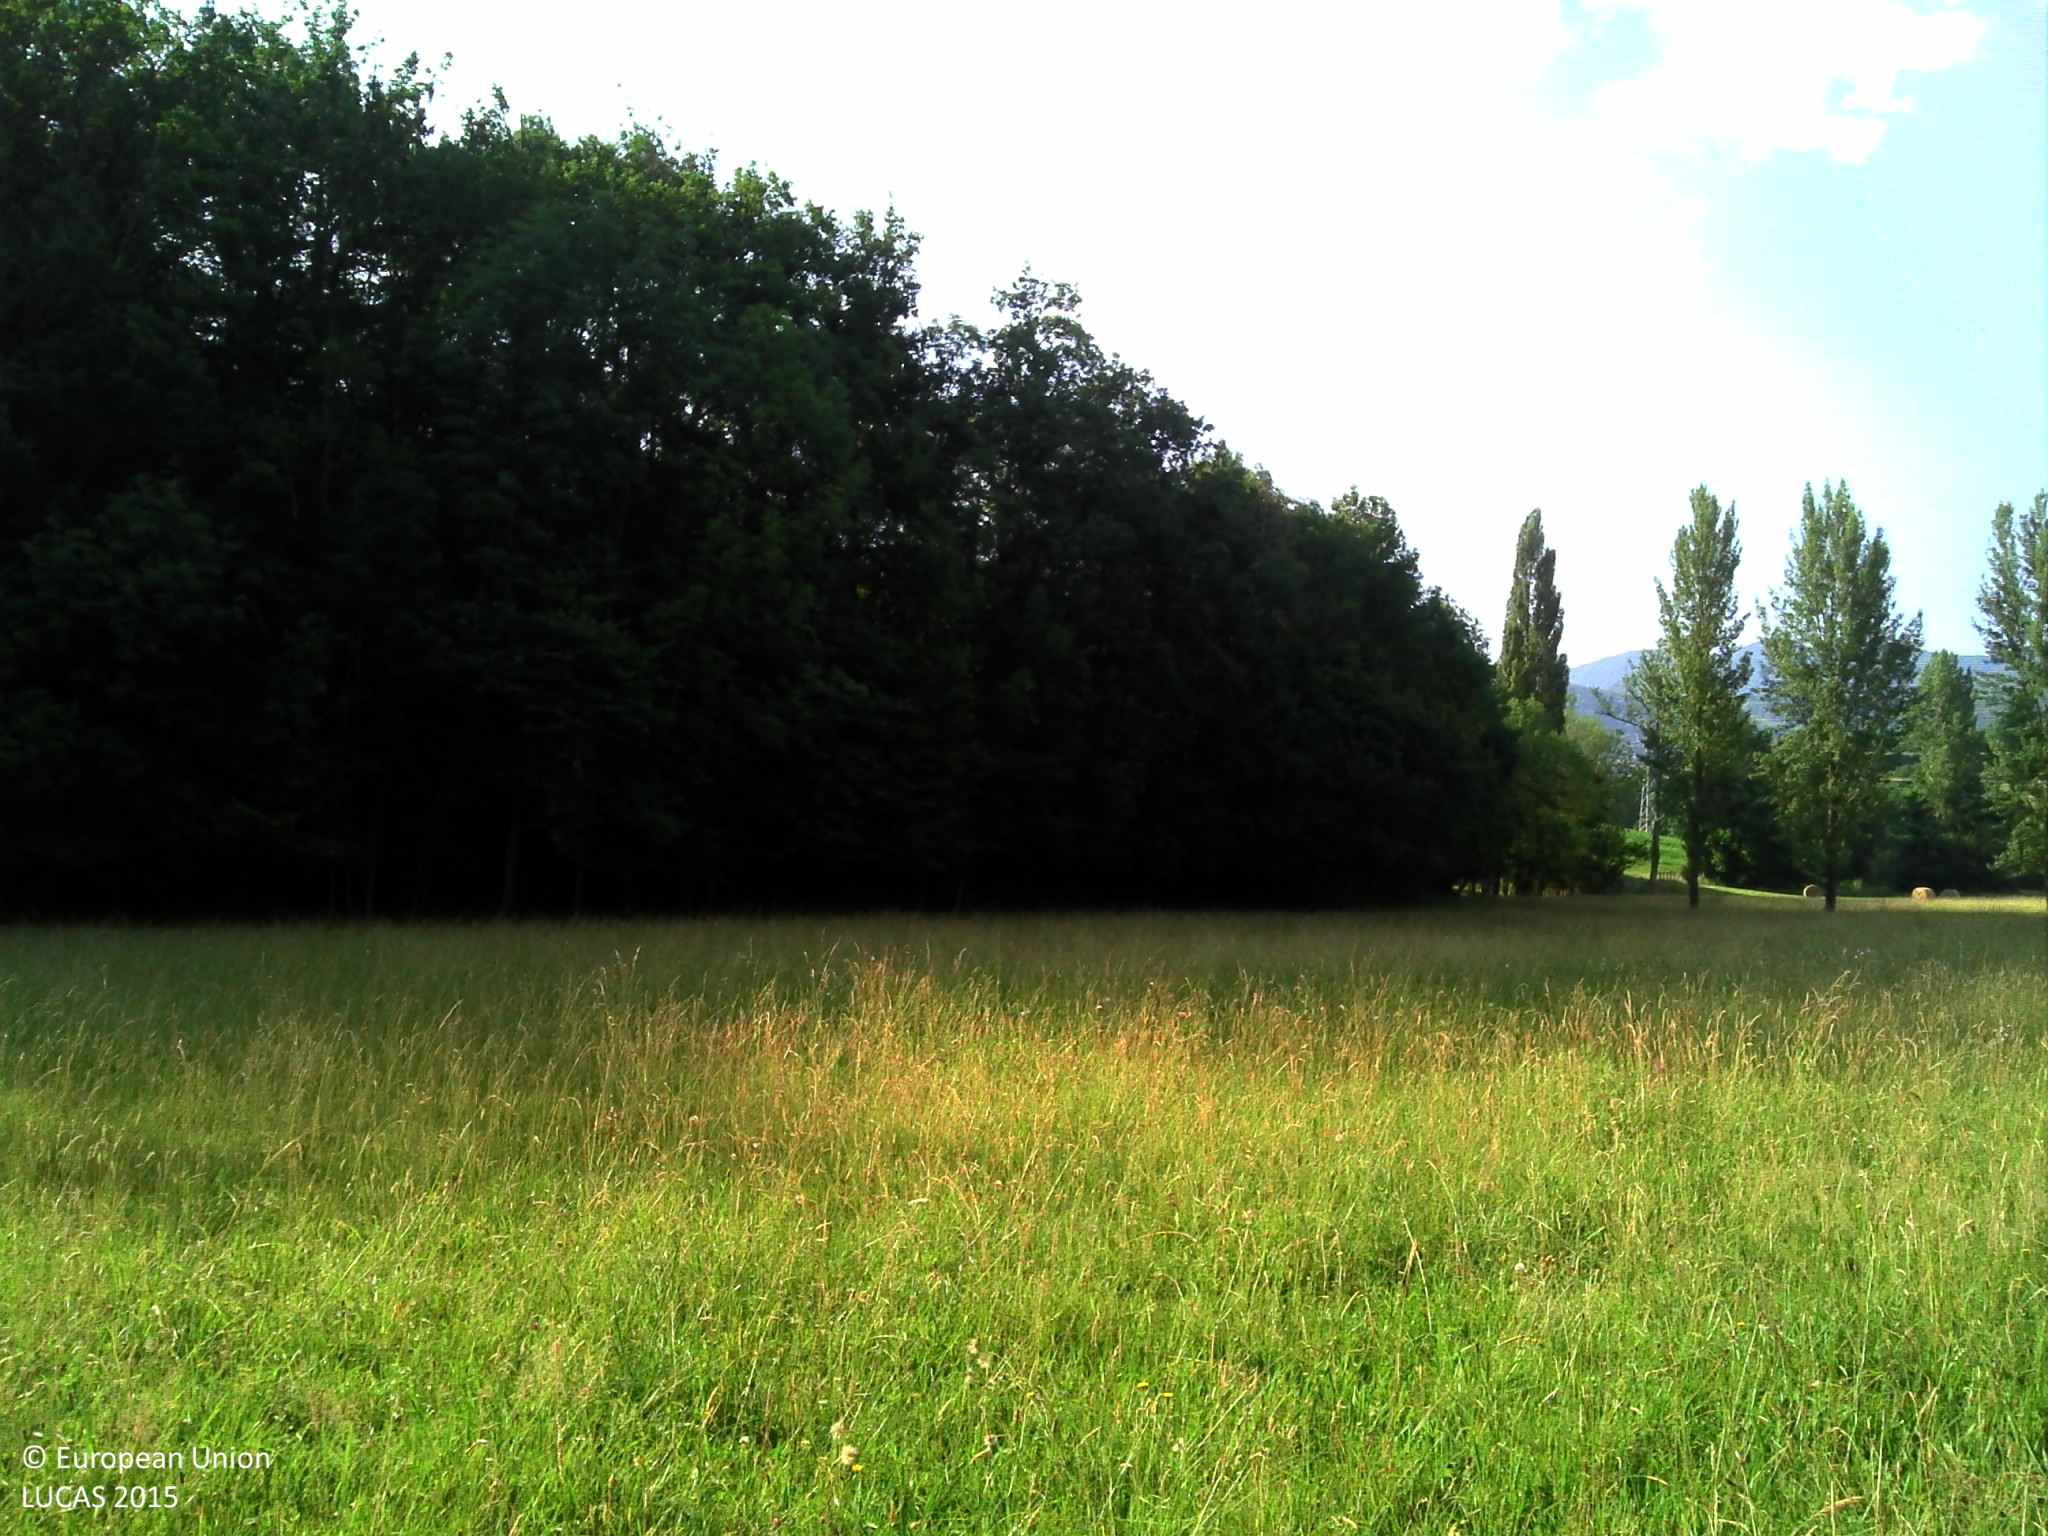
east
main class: Grassland
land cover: Grassland without tree/shrub cover
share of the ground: > 75 %
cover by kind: herbaceous plants 100 %
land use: Agriculture (excluding fallow land and kitchen gardens)
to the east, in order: Grassland without tree/shrub cover; Broadleaved woodland; Grassland with sparse tree/shrub cover
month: July
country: FR
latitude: 42.9889
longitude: 1.1128
